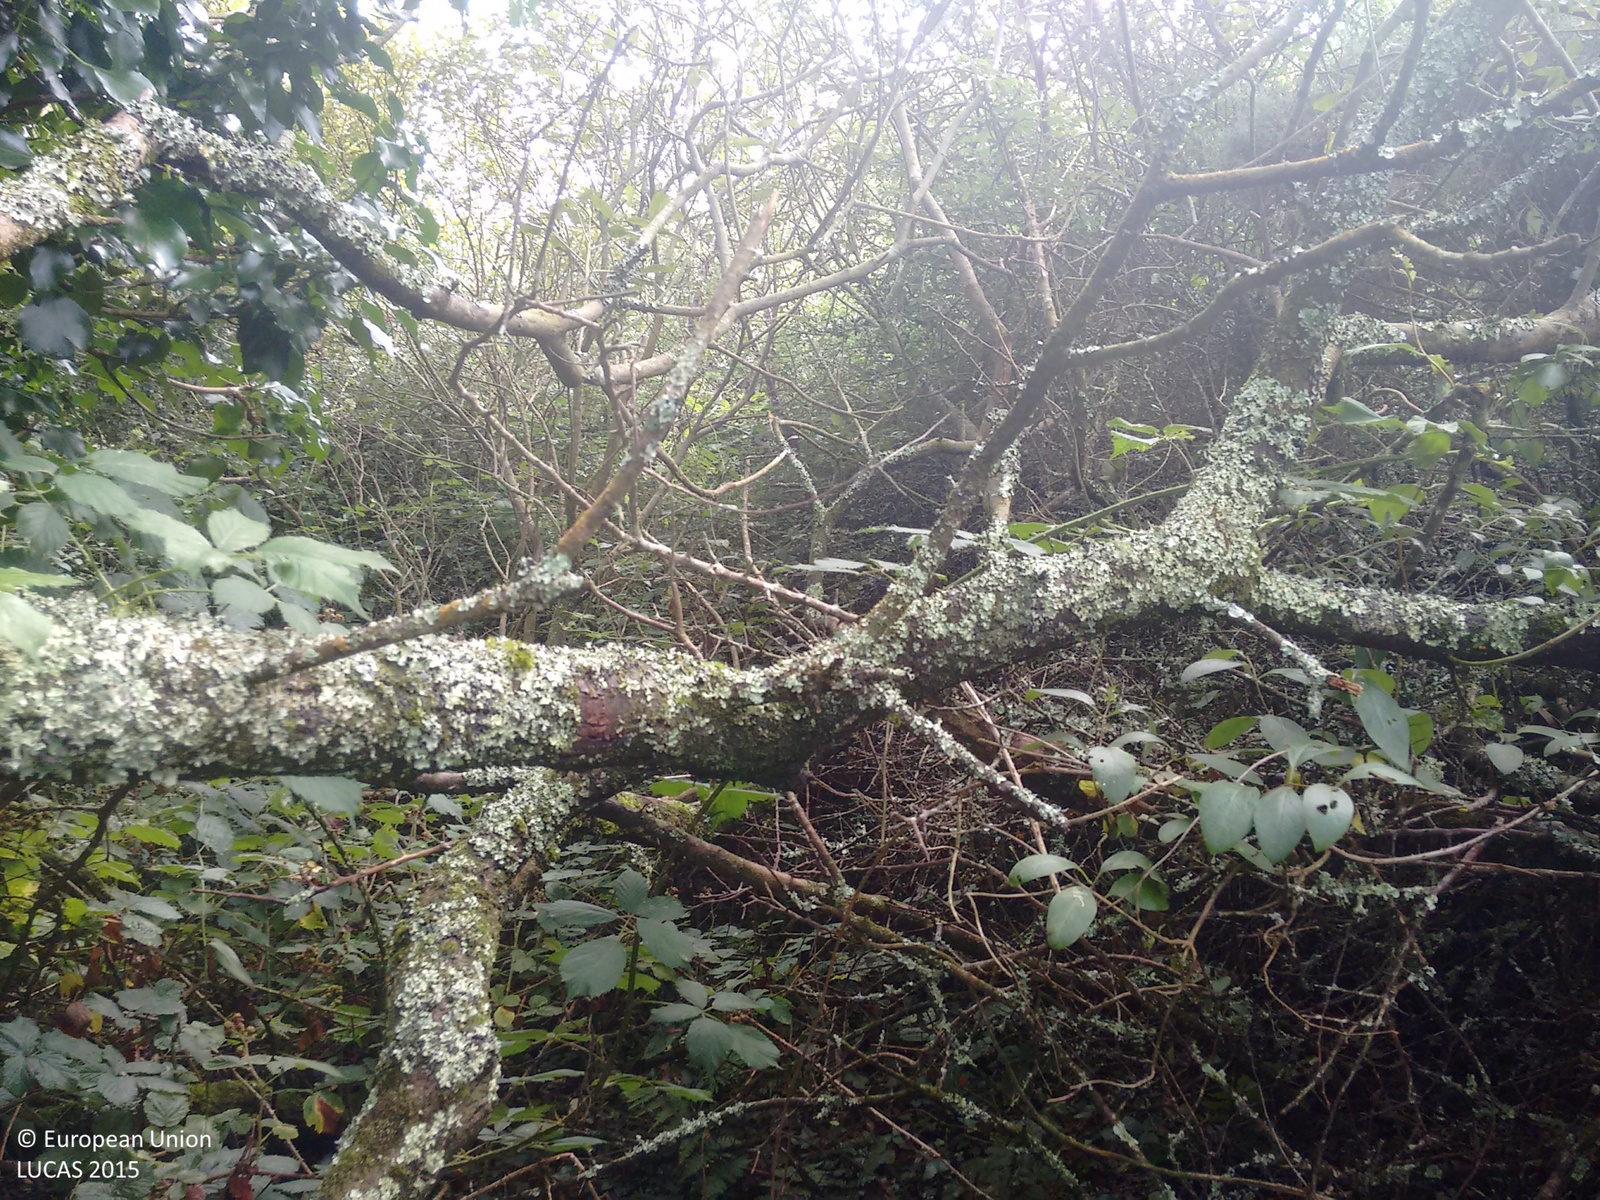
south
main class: Woodland
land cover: Broadleaved woodland
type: mesophytic deciduous forest
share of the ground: > 75 %
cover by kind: broadleaved forest trees 100 %
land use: Forestry
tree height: > 5 m
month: August
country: GB
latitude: 49.9990
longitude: -5.2007
